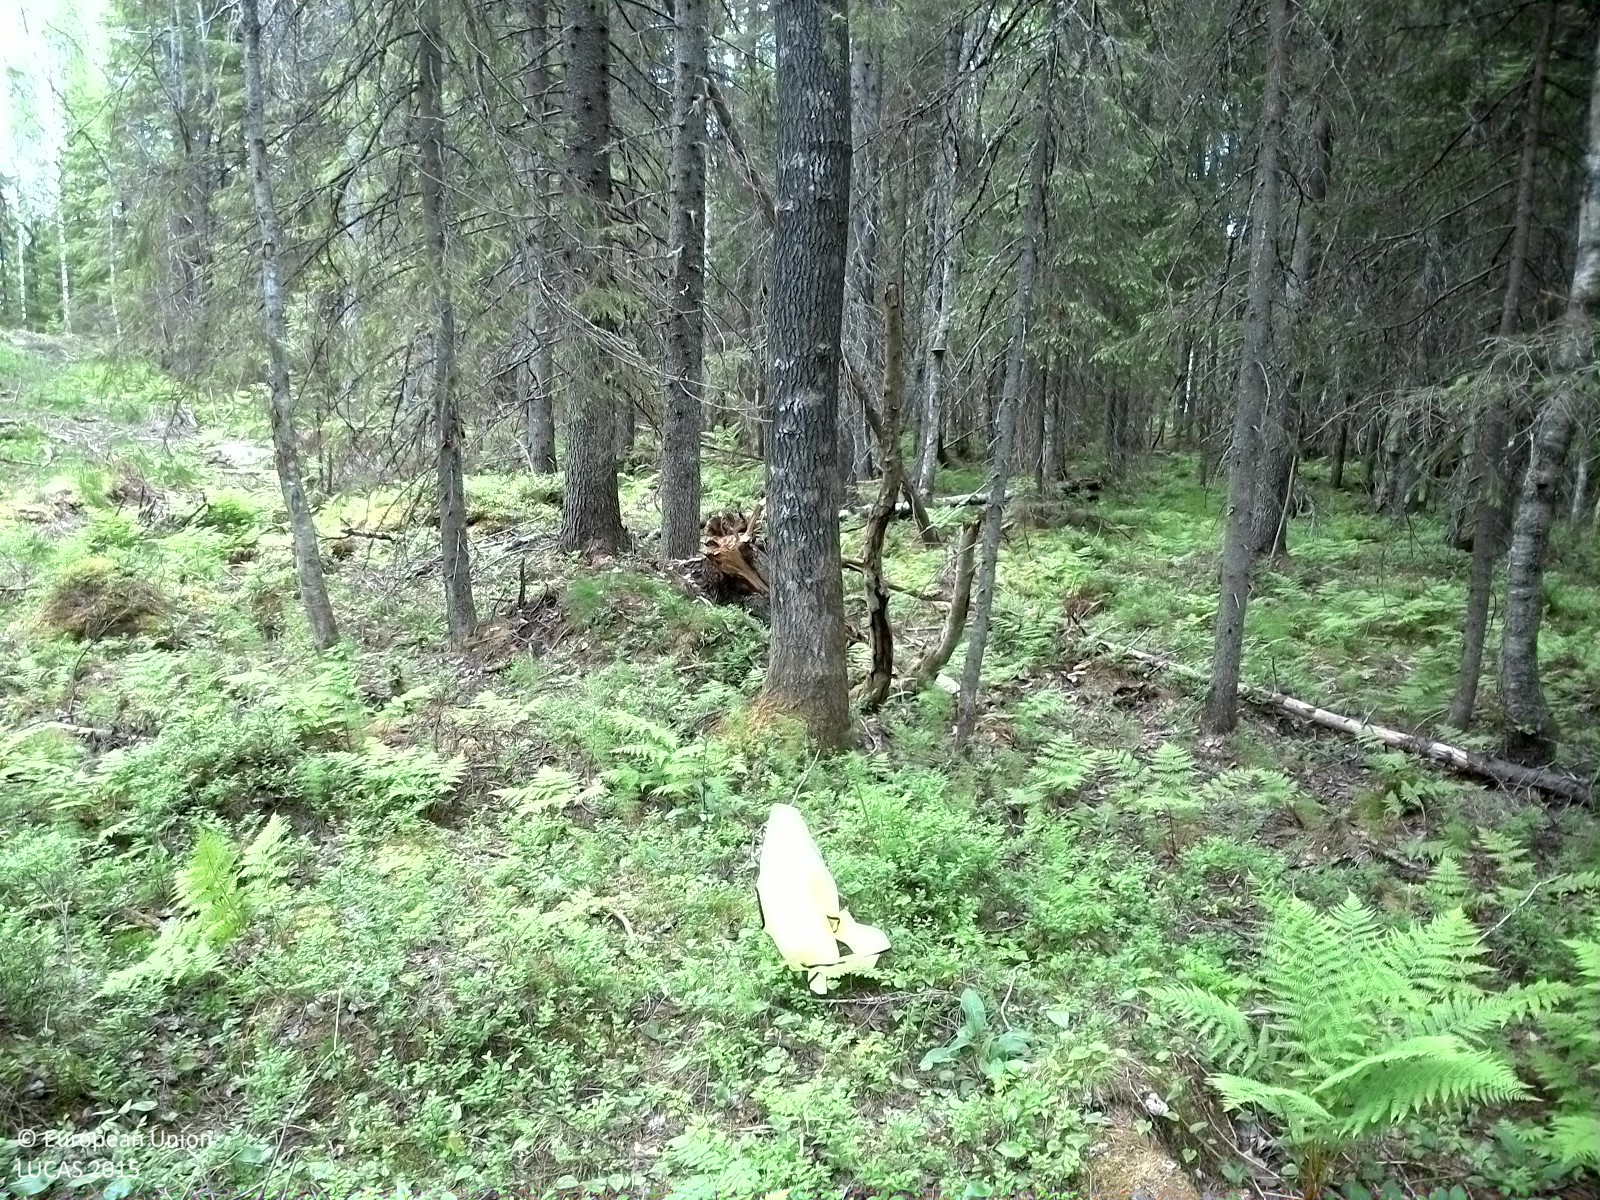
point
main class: Woodland
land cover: Spruce dominated coniferous woodland
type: boreal forest
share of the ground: 50 - 75 %
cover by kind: coniferous forest trees 50 %, shrubs 20 %, broadleaved forest trees 10 %, herbaceous plants 10 %, lichens and mosses 10 %
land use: Forestry
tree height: > 5 m
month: July
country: SE
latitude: 62.2212
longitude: 16.8471
